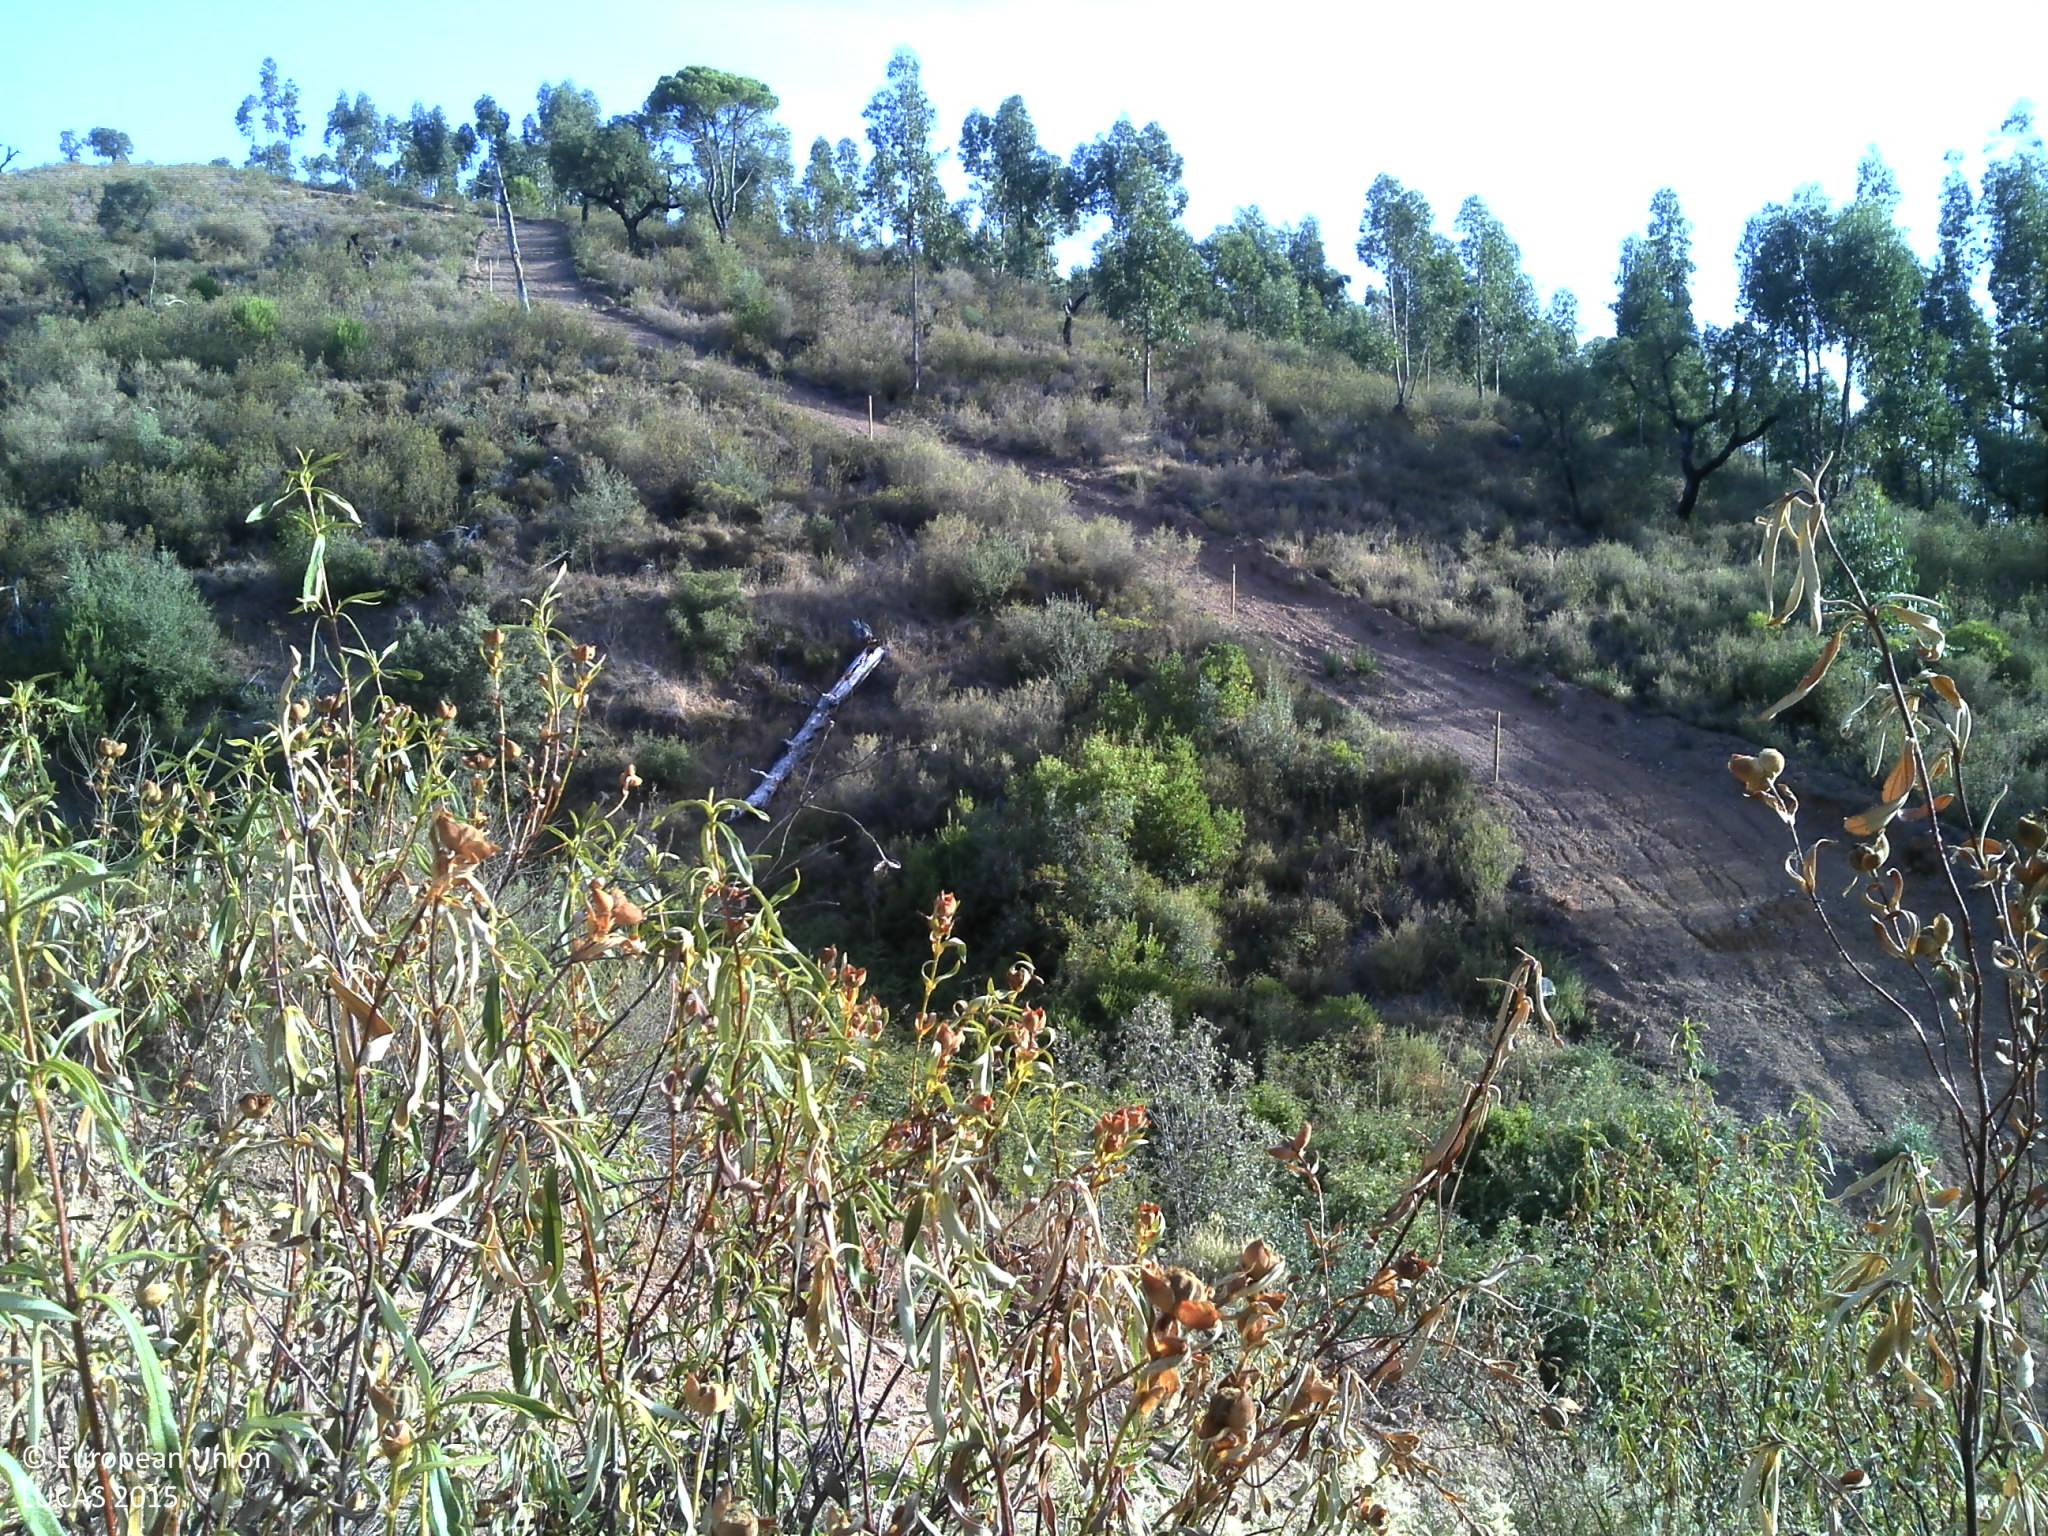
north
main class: Woodland
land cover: Pine dominated coniferous woodland
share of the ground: 10 - 25 %
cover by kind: shrubs 75 %, coniferous forest trees 10 %, unconsolidated bare surface 10 %, herbaceous plants 5 %
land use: Forestry
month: July
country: PT
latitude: 38.3286
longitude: -7.7037
